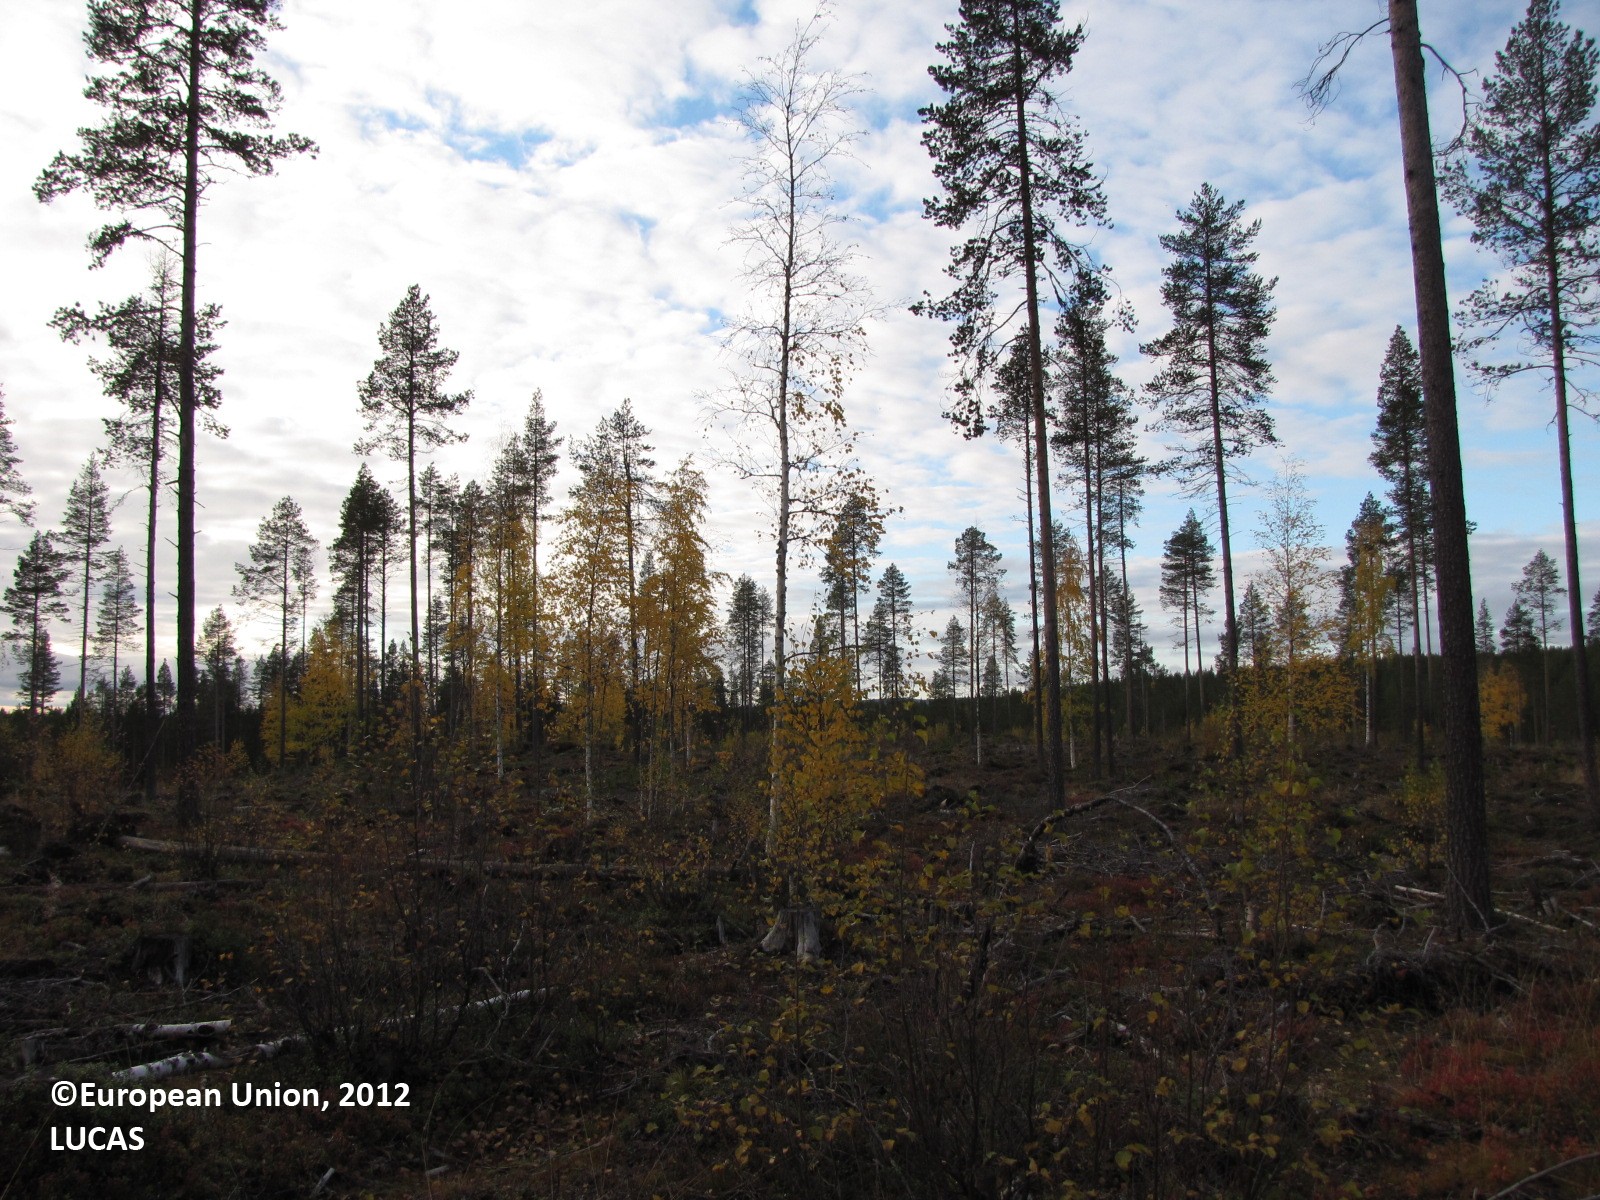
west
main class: Grassland
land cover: Grassland with sparse tree/shrub cover
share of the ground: 10 - 25 %
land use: Forestry
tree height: < 5 m
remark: Clear cut
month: September
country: FI
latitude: 67.4458
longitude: 23.7340
